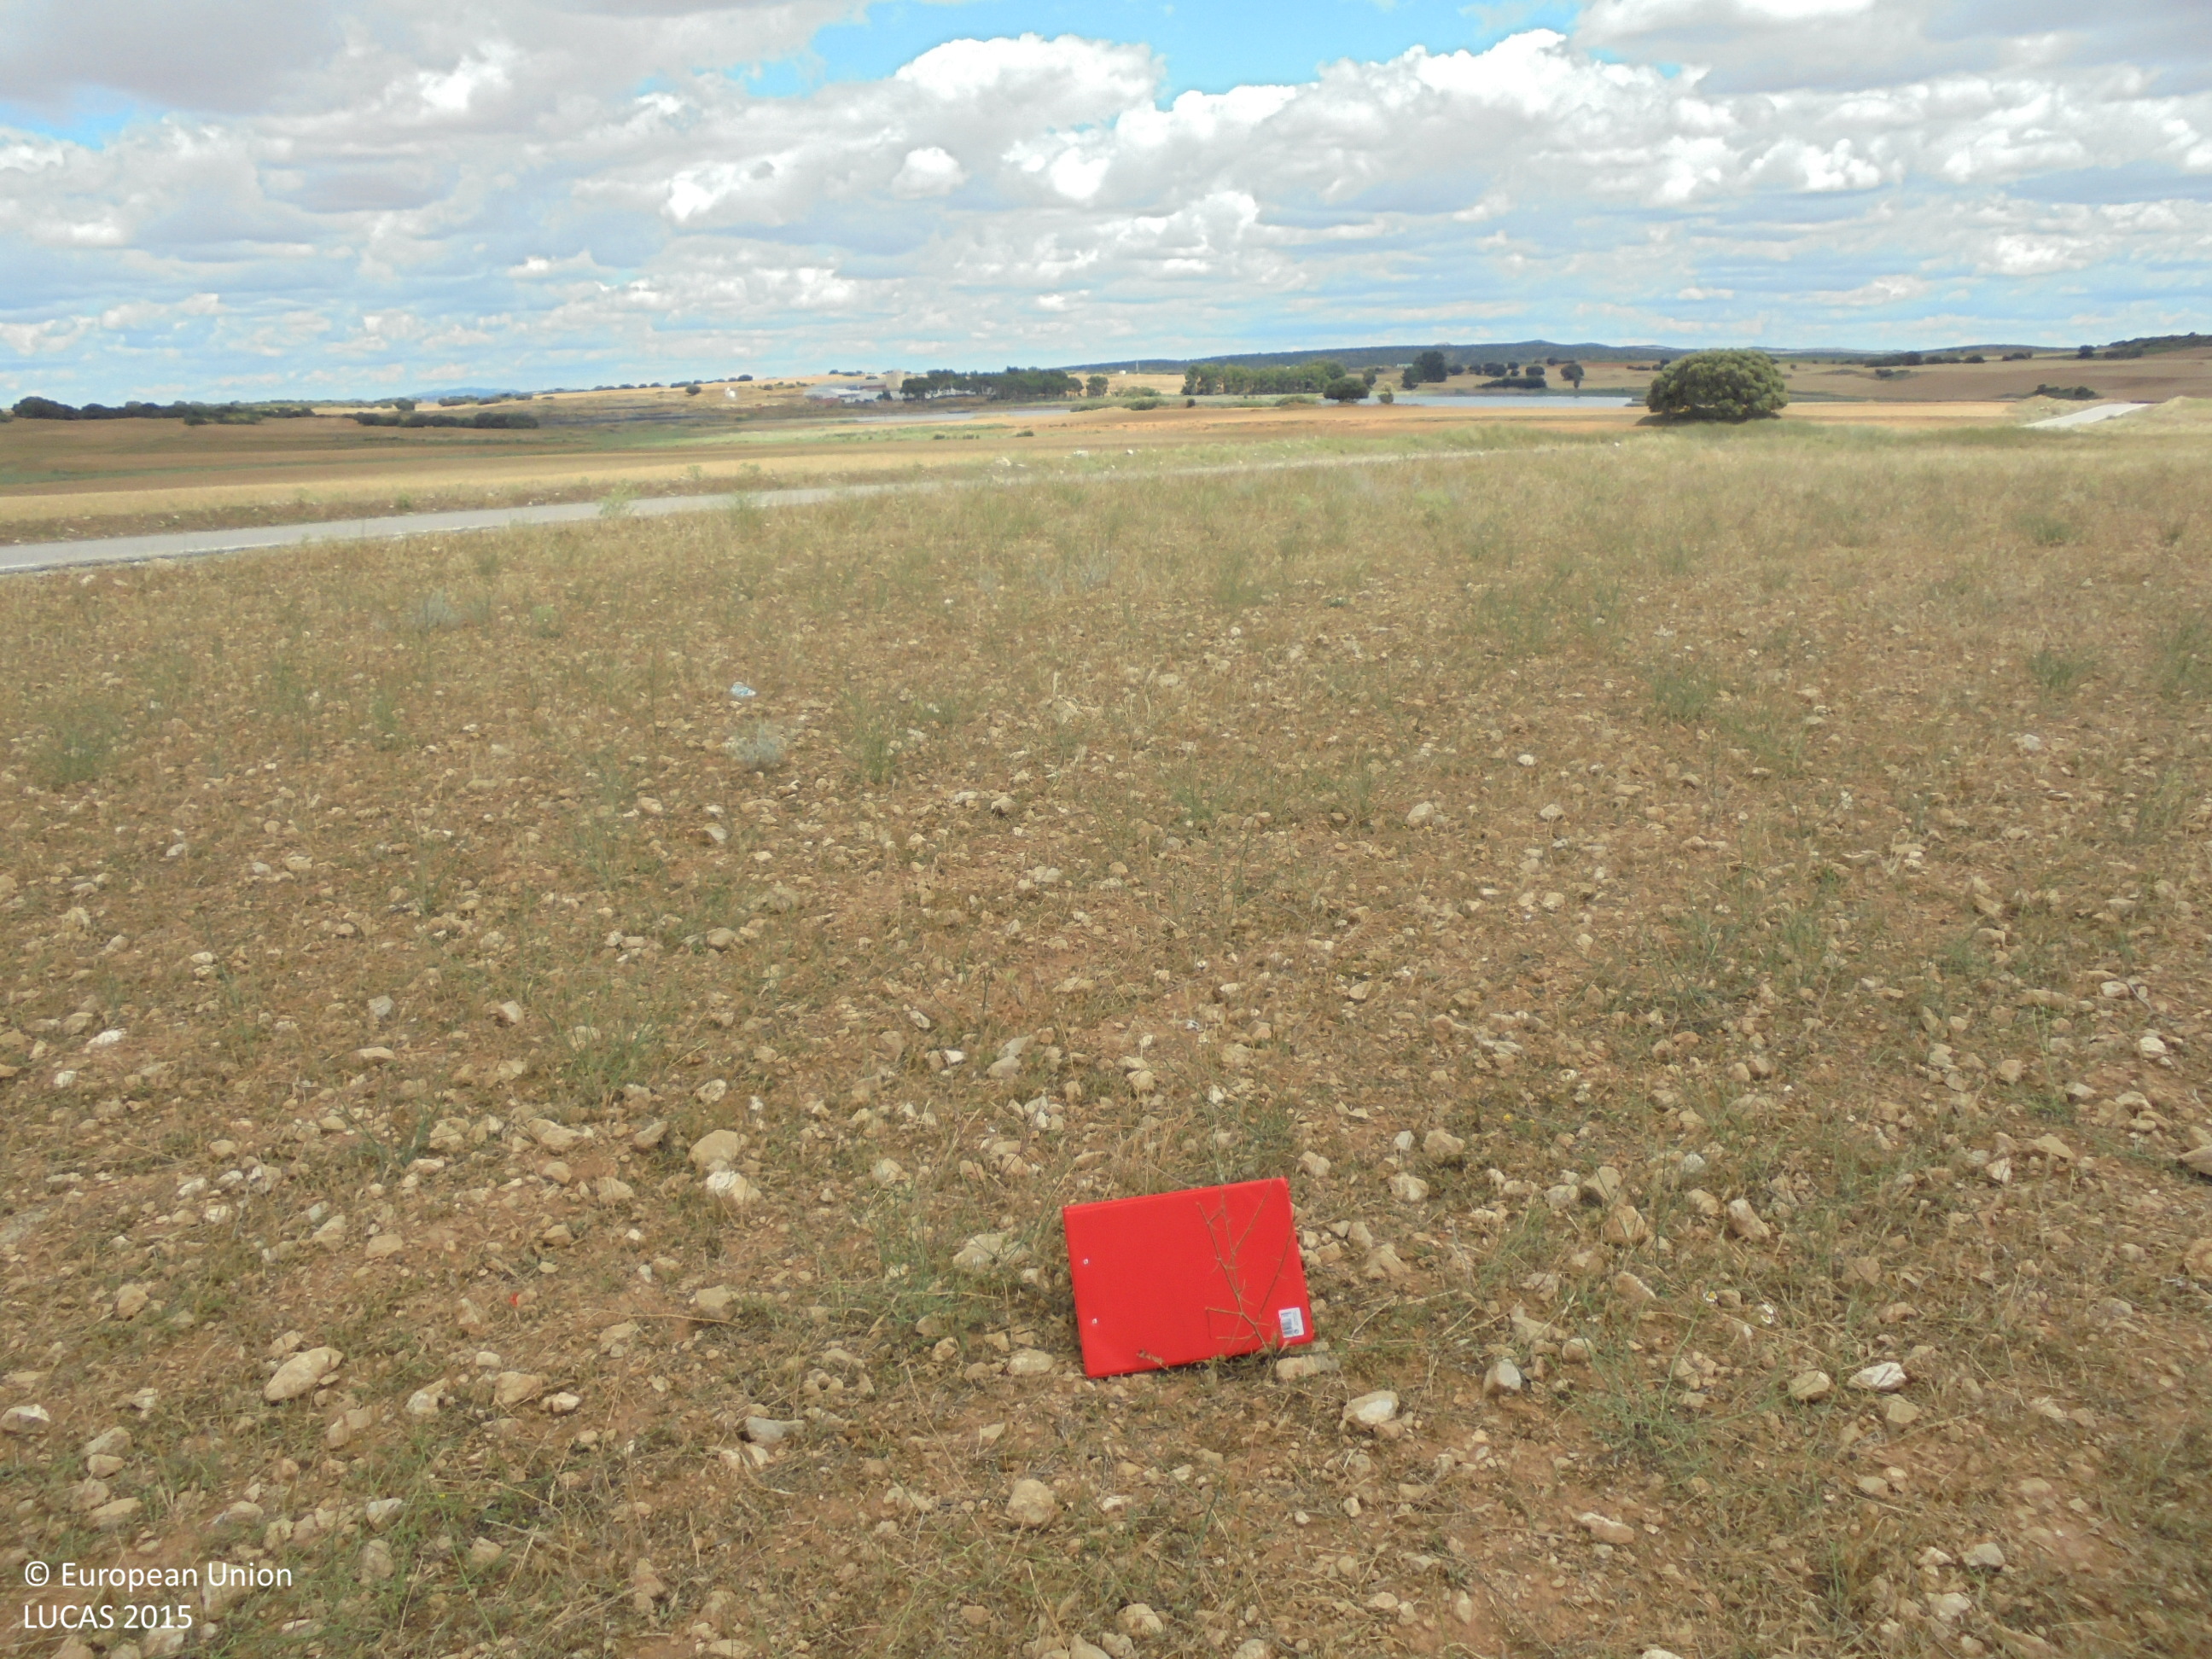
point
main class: Grassland
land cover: Spontaneously vegetated surfaces
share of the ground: 25 - 50 %
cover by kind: unconsolidated bare surface 55 %, herbaceous plants 45 %
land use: Agriculture (excluding fallow land and kitchen gardens)
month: June
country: ES
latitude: 38.7936
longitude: -1.4279
